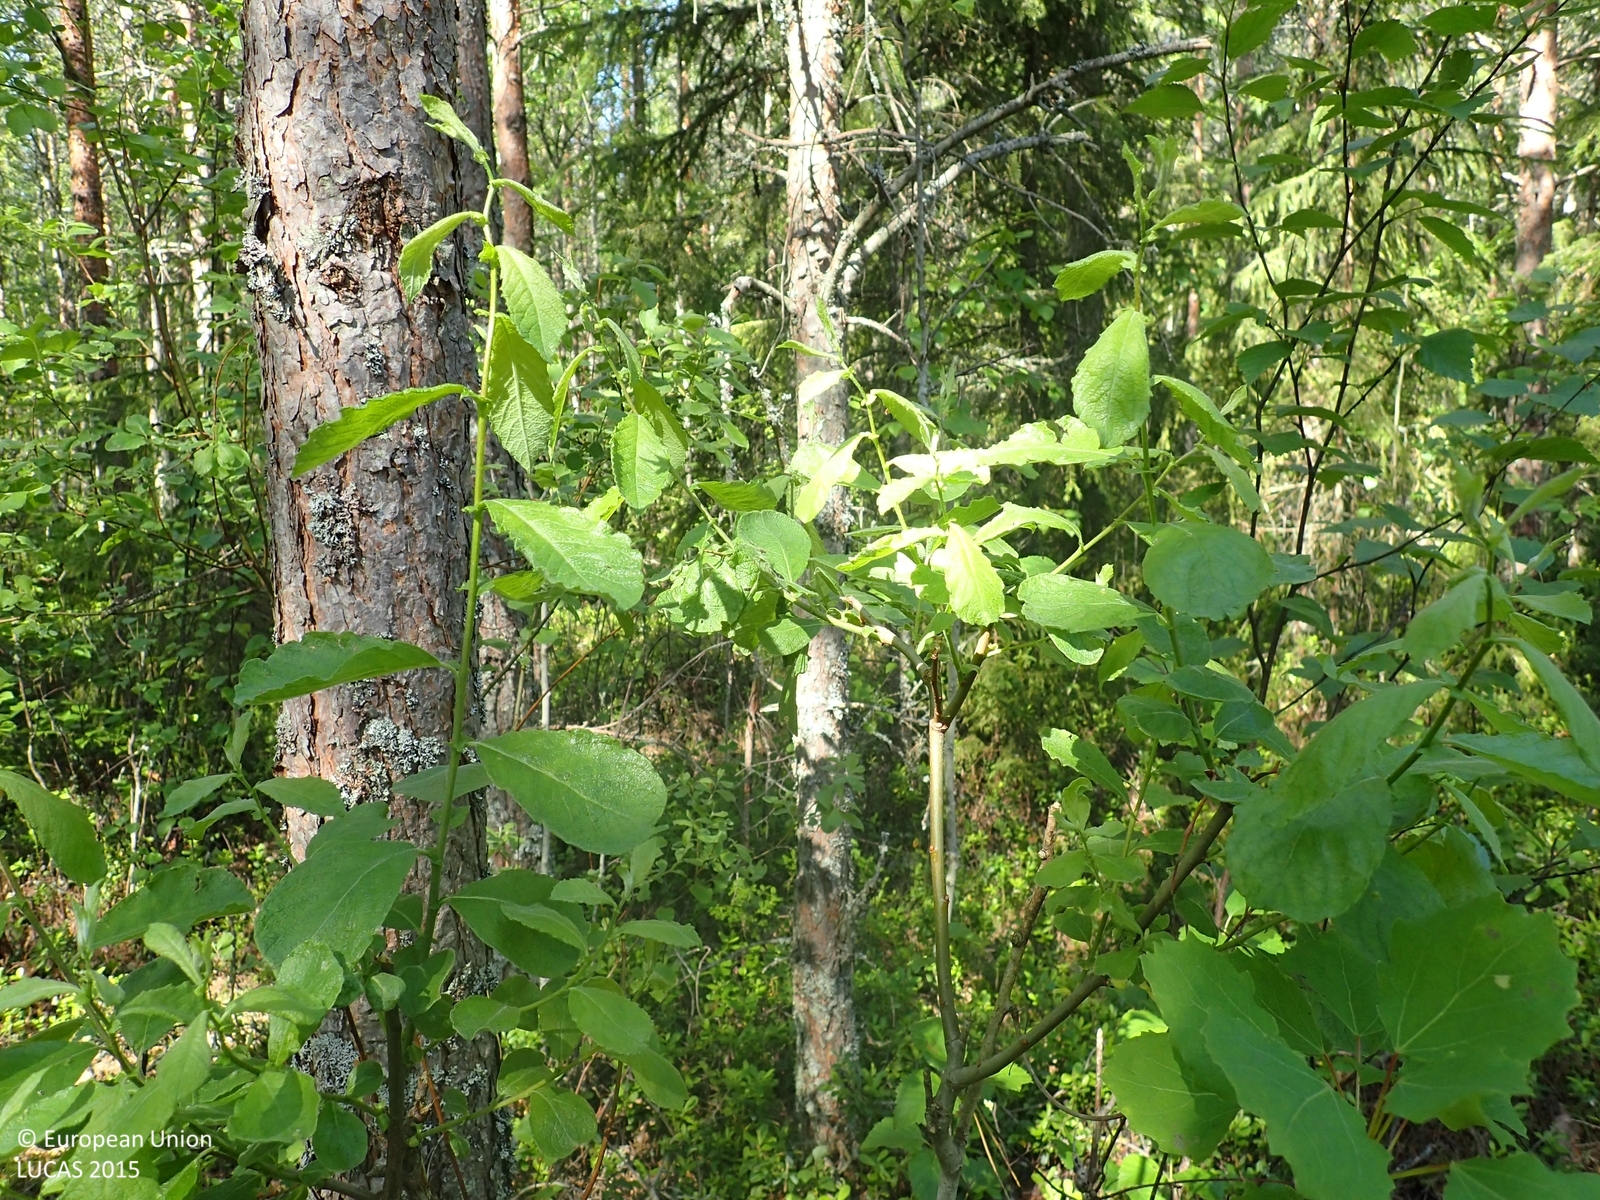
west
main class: Woodland
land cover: Pine dominated coniferous woodland
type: boreal forest
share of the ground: 50 - 75 %
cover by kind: coniferous forest trees 50 %, shrubs 40 %, broadleaved forest trees 10 %
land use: Forestry
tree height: > 5 m
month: July
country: FI
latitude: 62.6987
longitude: 21.5135
